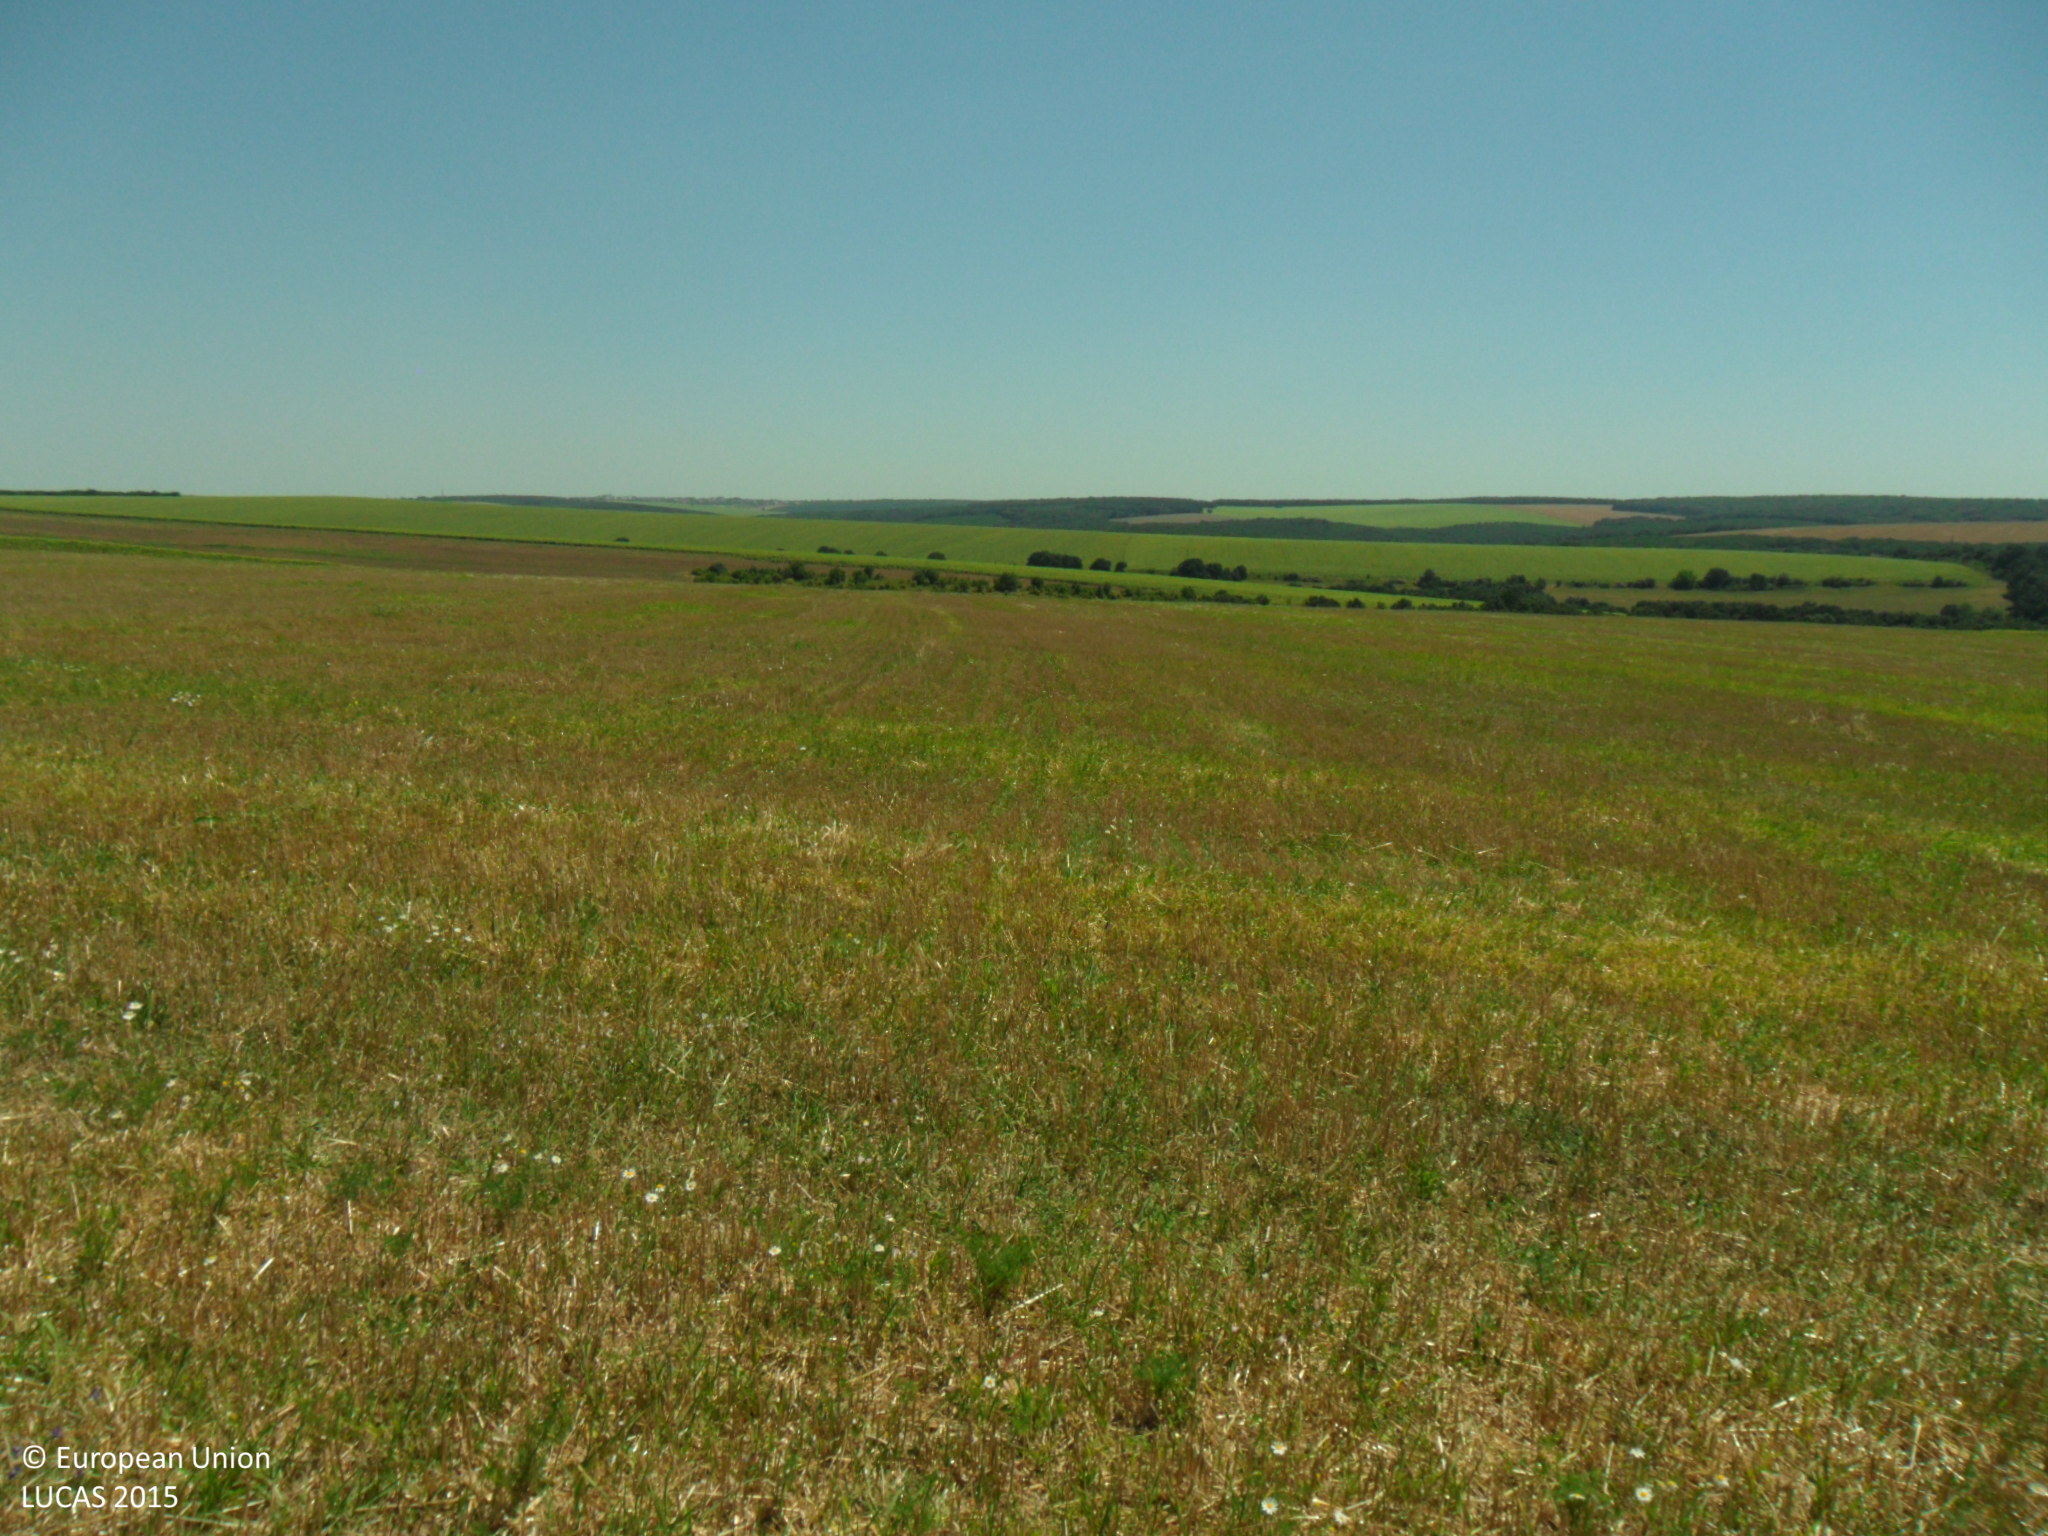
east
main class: Cropland
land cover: Common wheat
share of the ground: > 75 %
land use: Agriculture (excluding fallow land and kitchen gardens)
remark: Harvested field
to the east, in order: Tracks; Barley
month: July
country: BG
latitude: 43.7889
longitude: 26.3970
